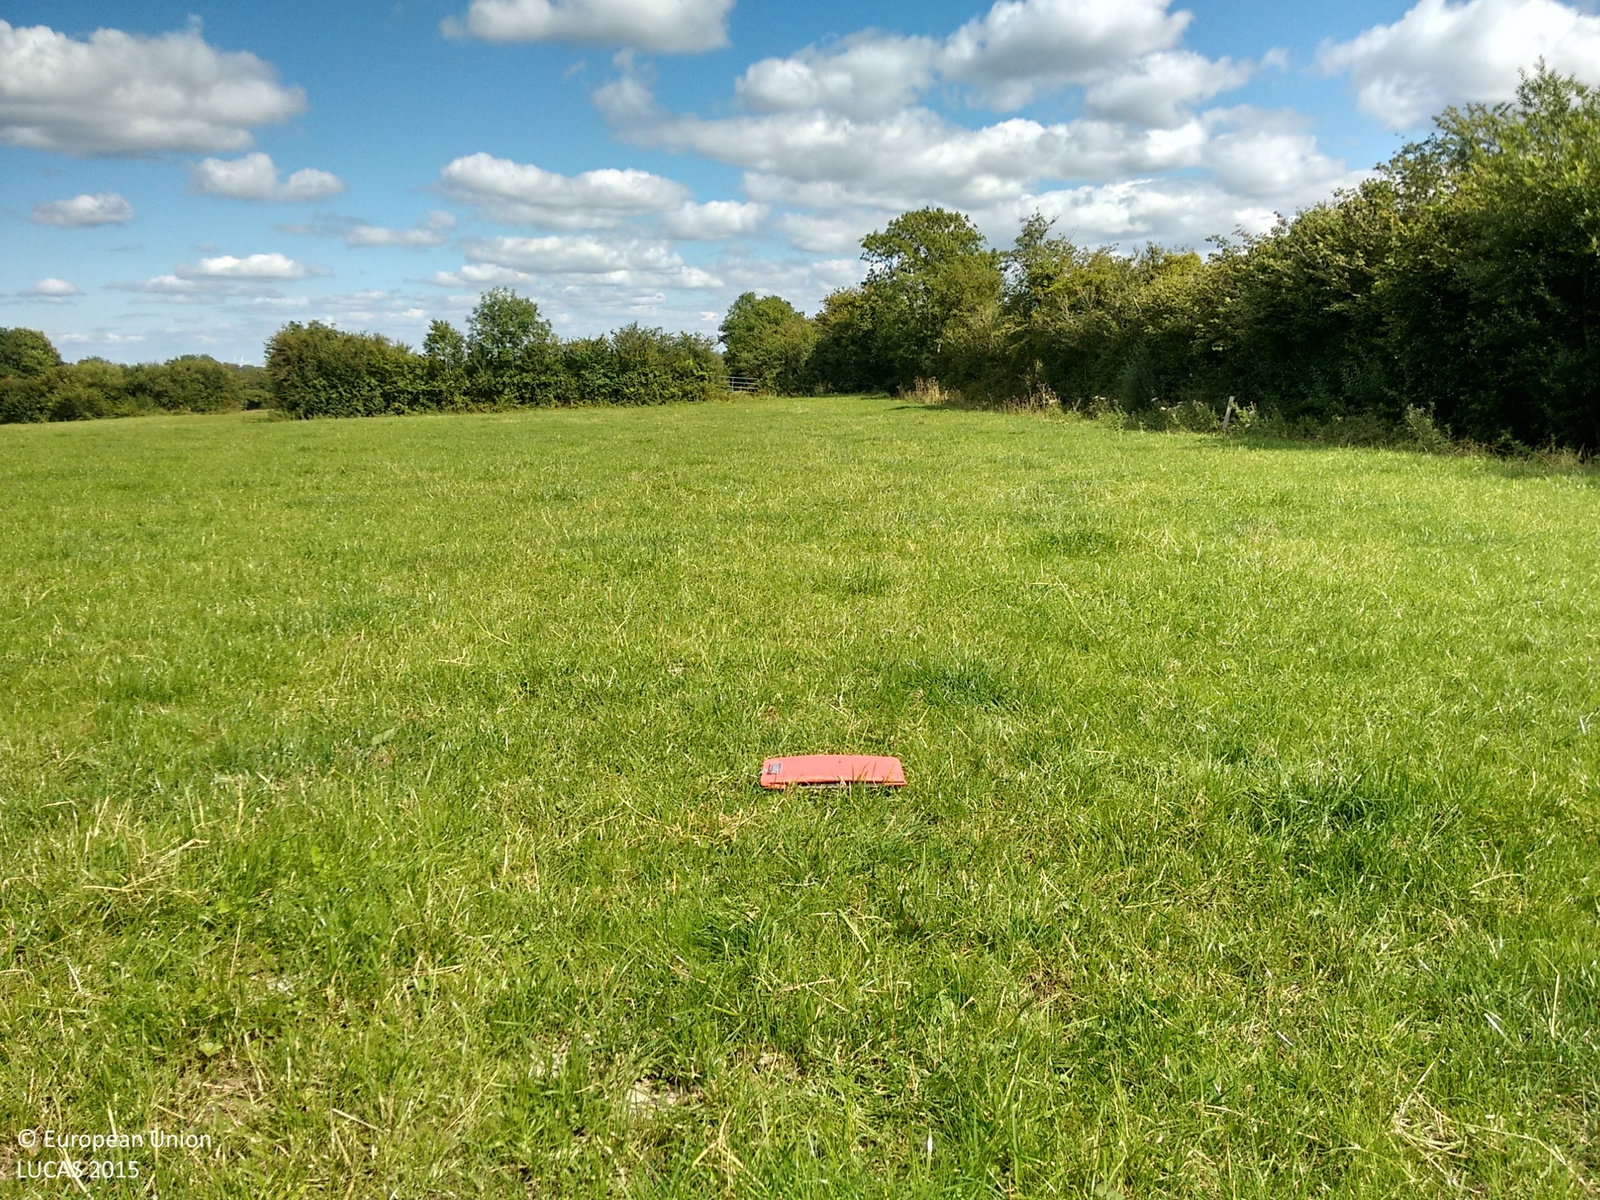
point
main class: Grassland
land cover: Grassland without tree/shrub cover
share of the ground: > 75 %
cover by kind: herbaceous plants 100 %
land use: Agriculture (excluding fallow land and kitchen gardens)
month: August
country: IE
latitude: 52.8906
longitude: -7.8424
